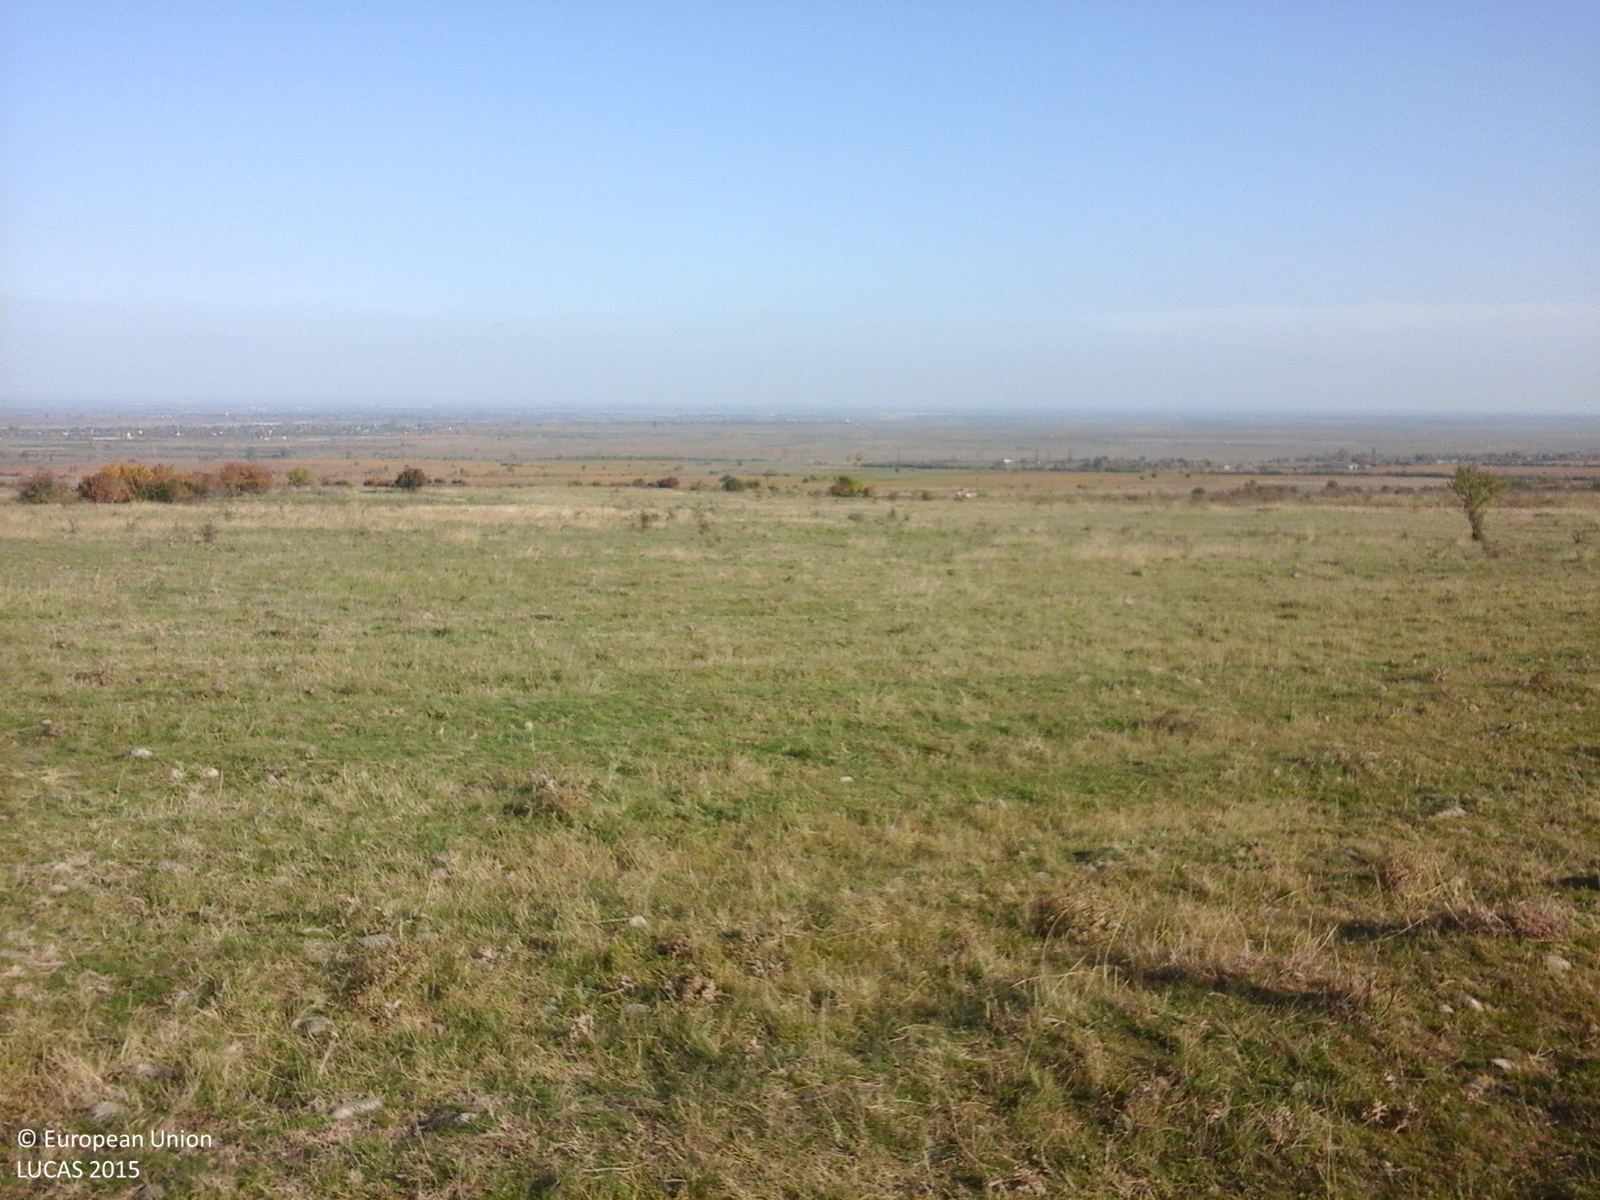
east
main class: Grassland
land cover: Grassland without tree/shrub cover
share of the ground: > 75 %
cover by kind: herbaceous plants 100 %
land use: Agriculture (excluding fallow land and kitchen gardens)
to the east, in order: Grassland without tree/shrub cover; Tracks; Grassland without tree/shrub cover
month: October
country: RO
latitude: 45.8167
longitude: 27.0415
